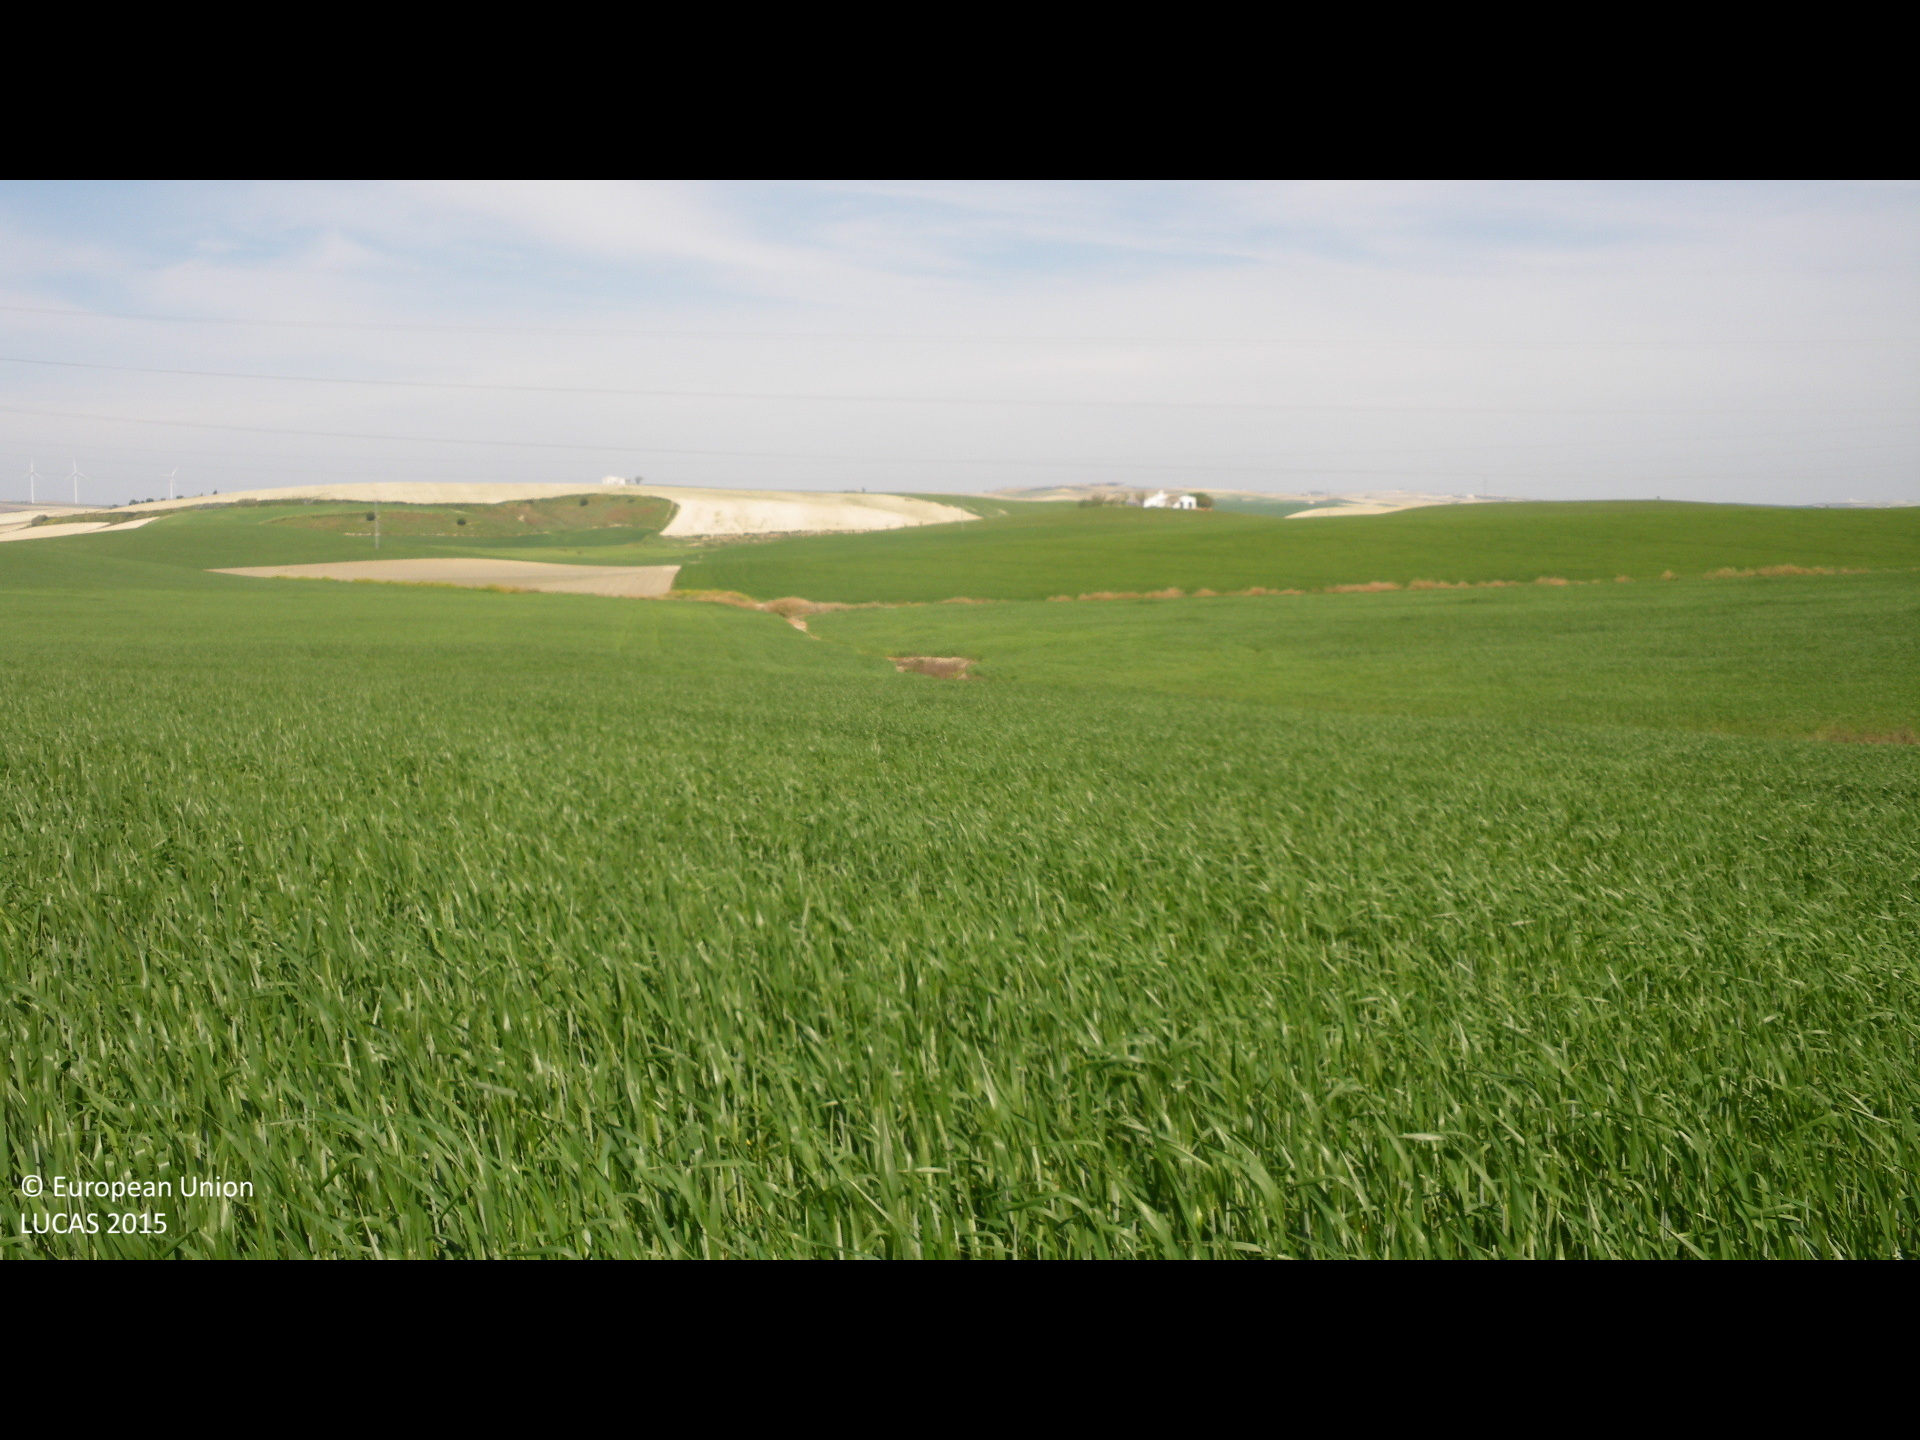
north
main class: Cropland
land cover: Common wheat
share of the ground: > 75 %
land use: Agriculture (excluding fallow land and kitchen gardens)
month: April
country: ES
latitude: 36.6442
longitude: -6.1972
